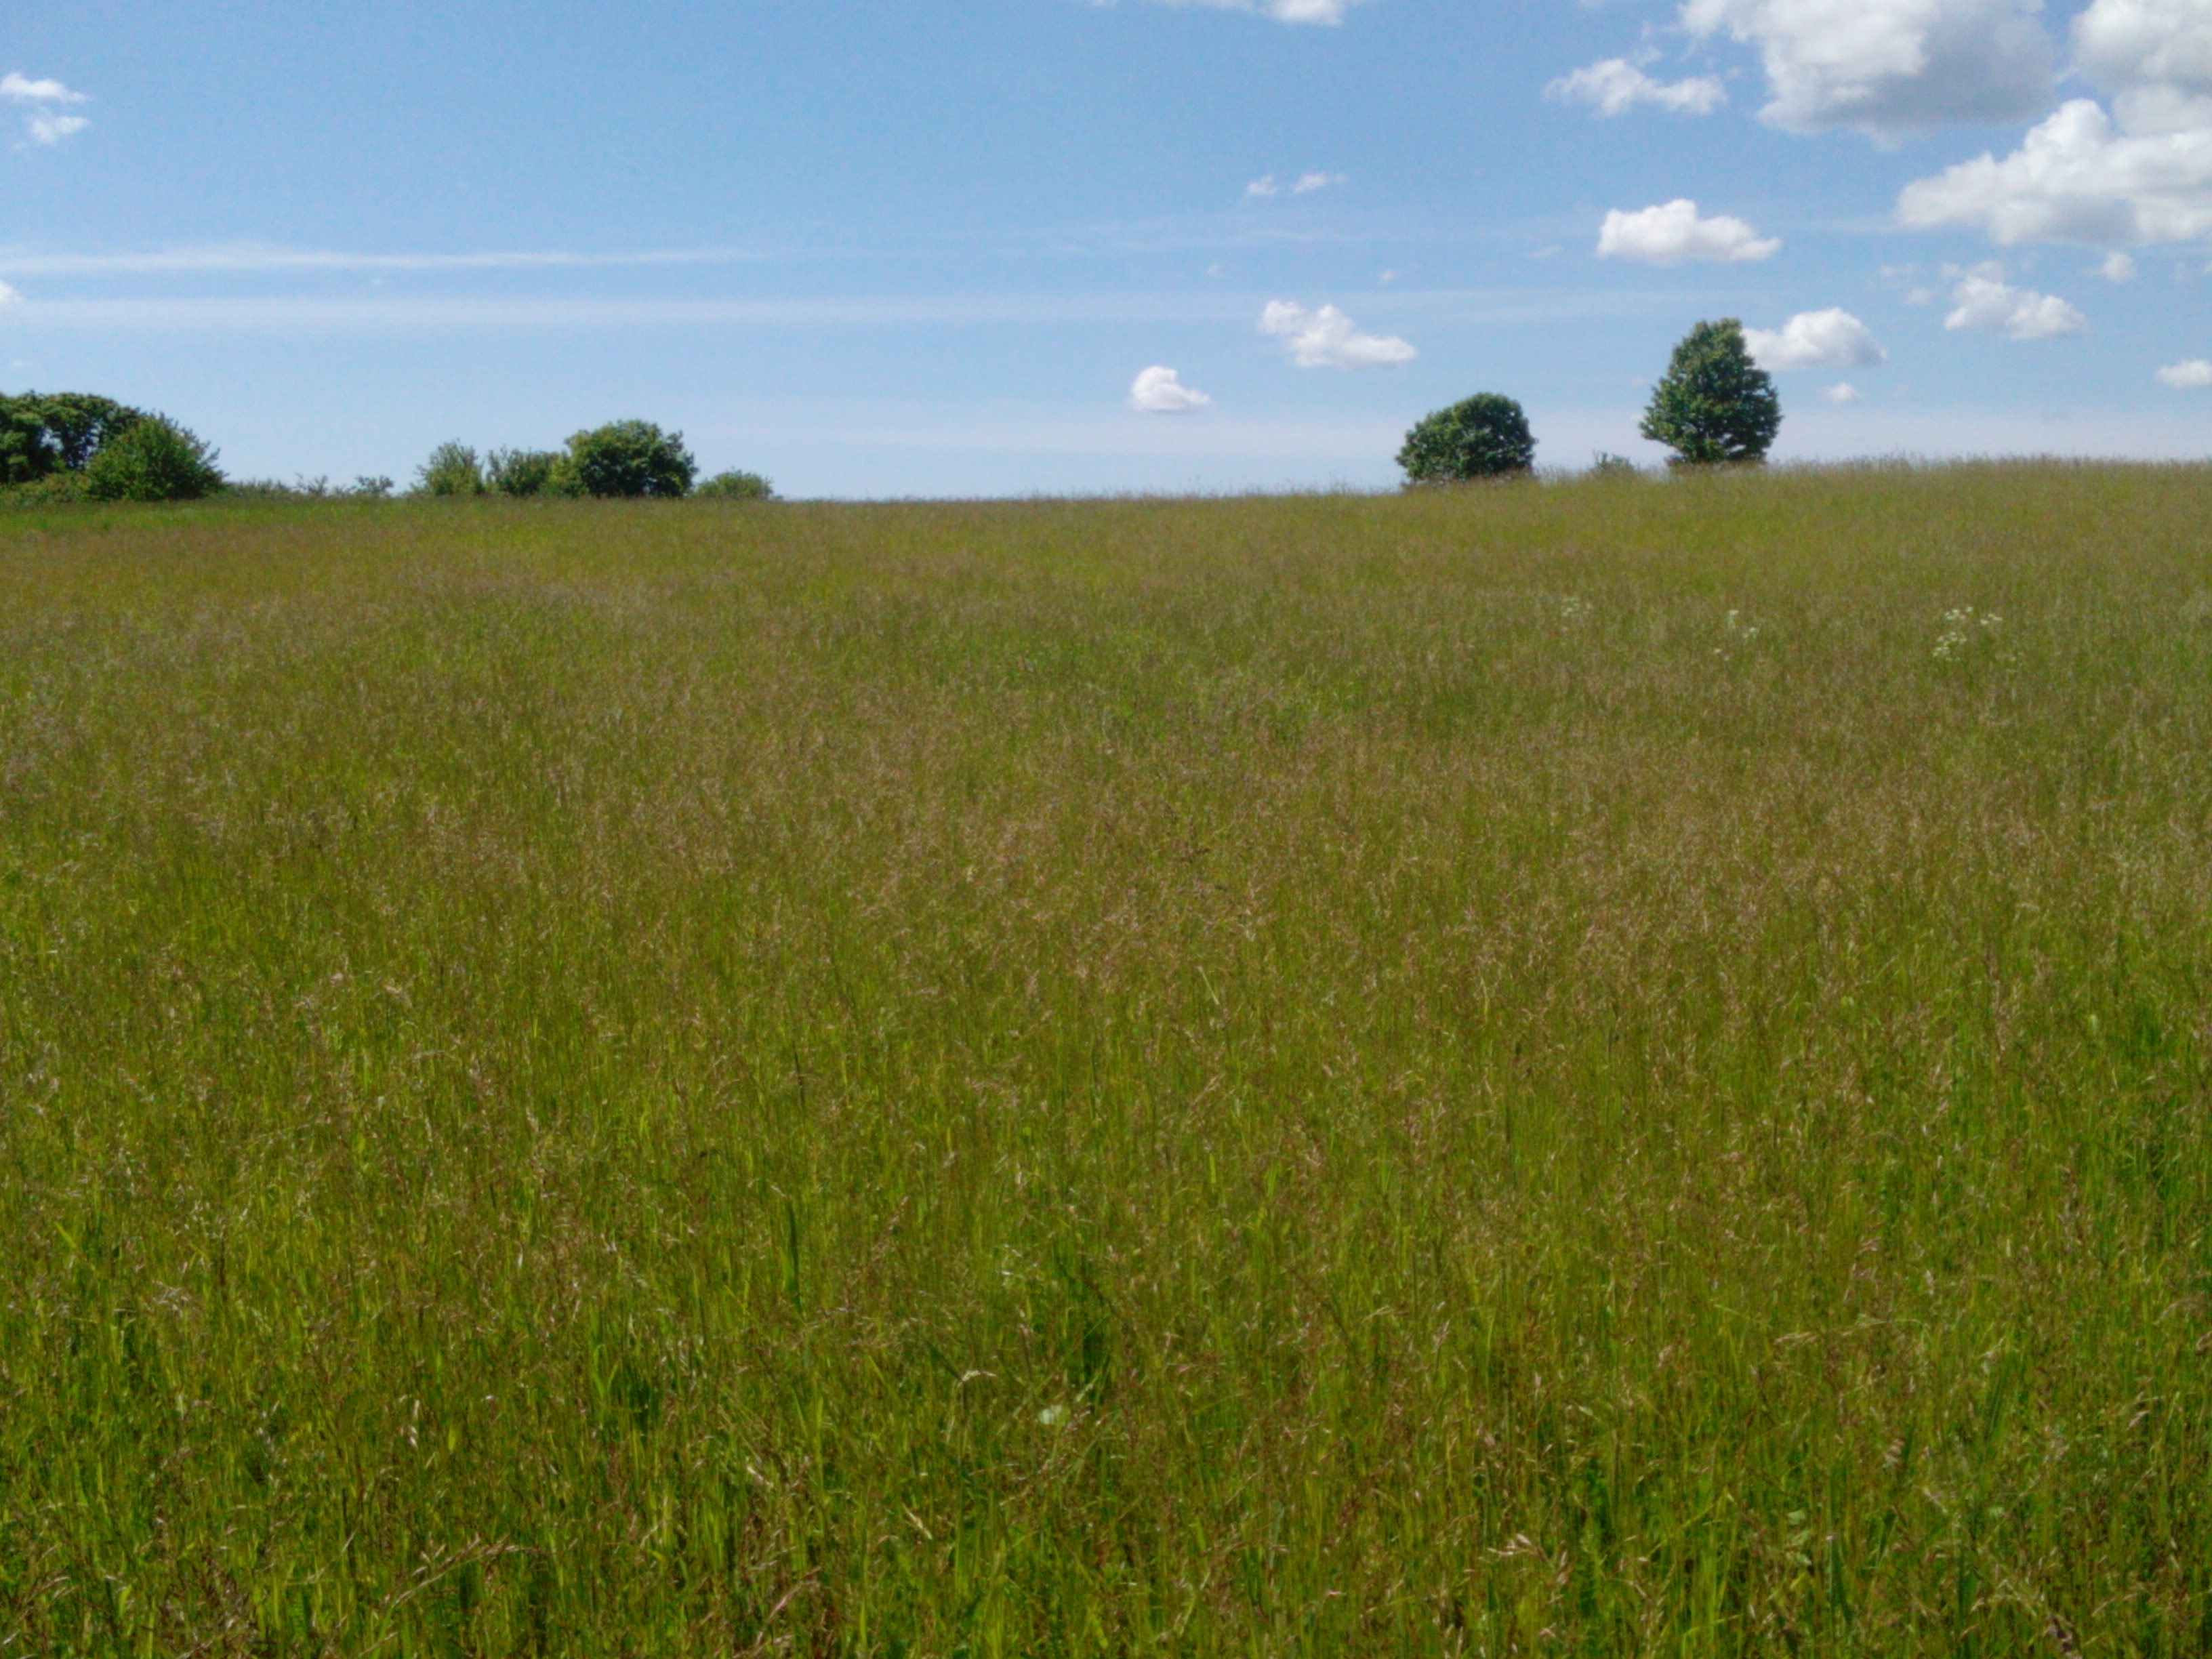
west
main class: Grassland
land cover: Grassland without tree/shrub cover
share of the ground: > 75 %
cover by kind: herbaceous plants 100 %
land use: Agriculture (excluding fallow land and kitchen gardens)
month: June
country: LV
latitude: 56.7919
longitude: 21.7501
